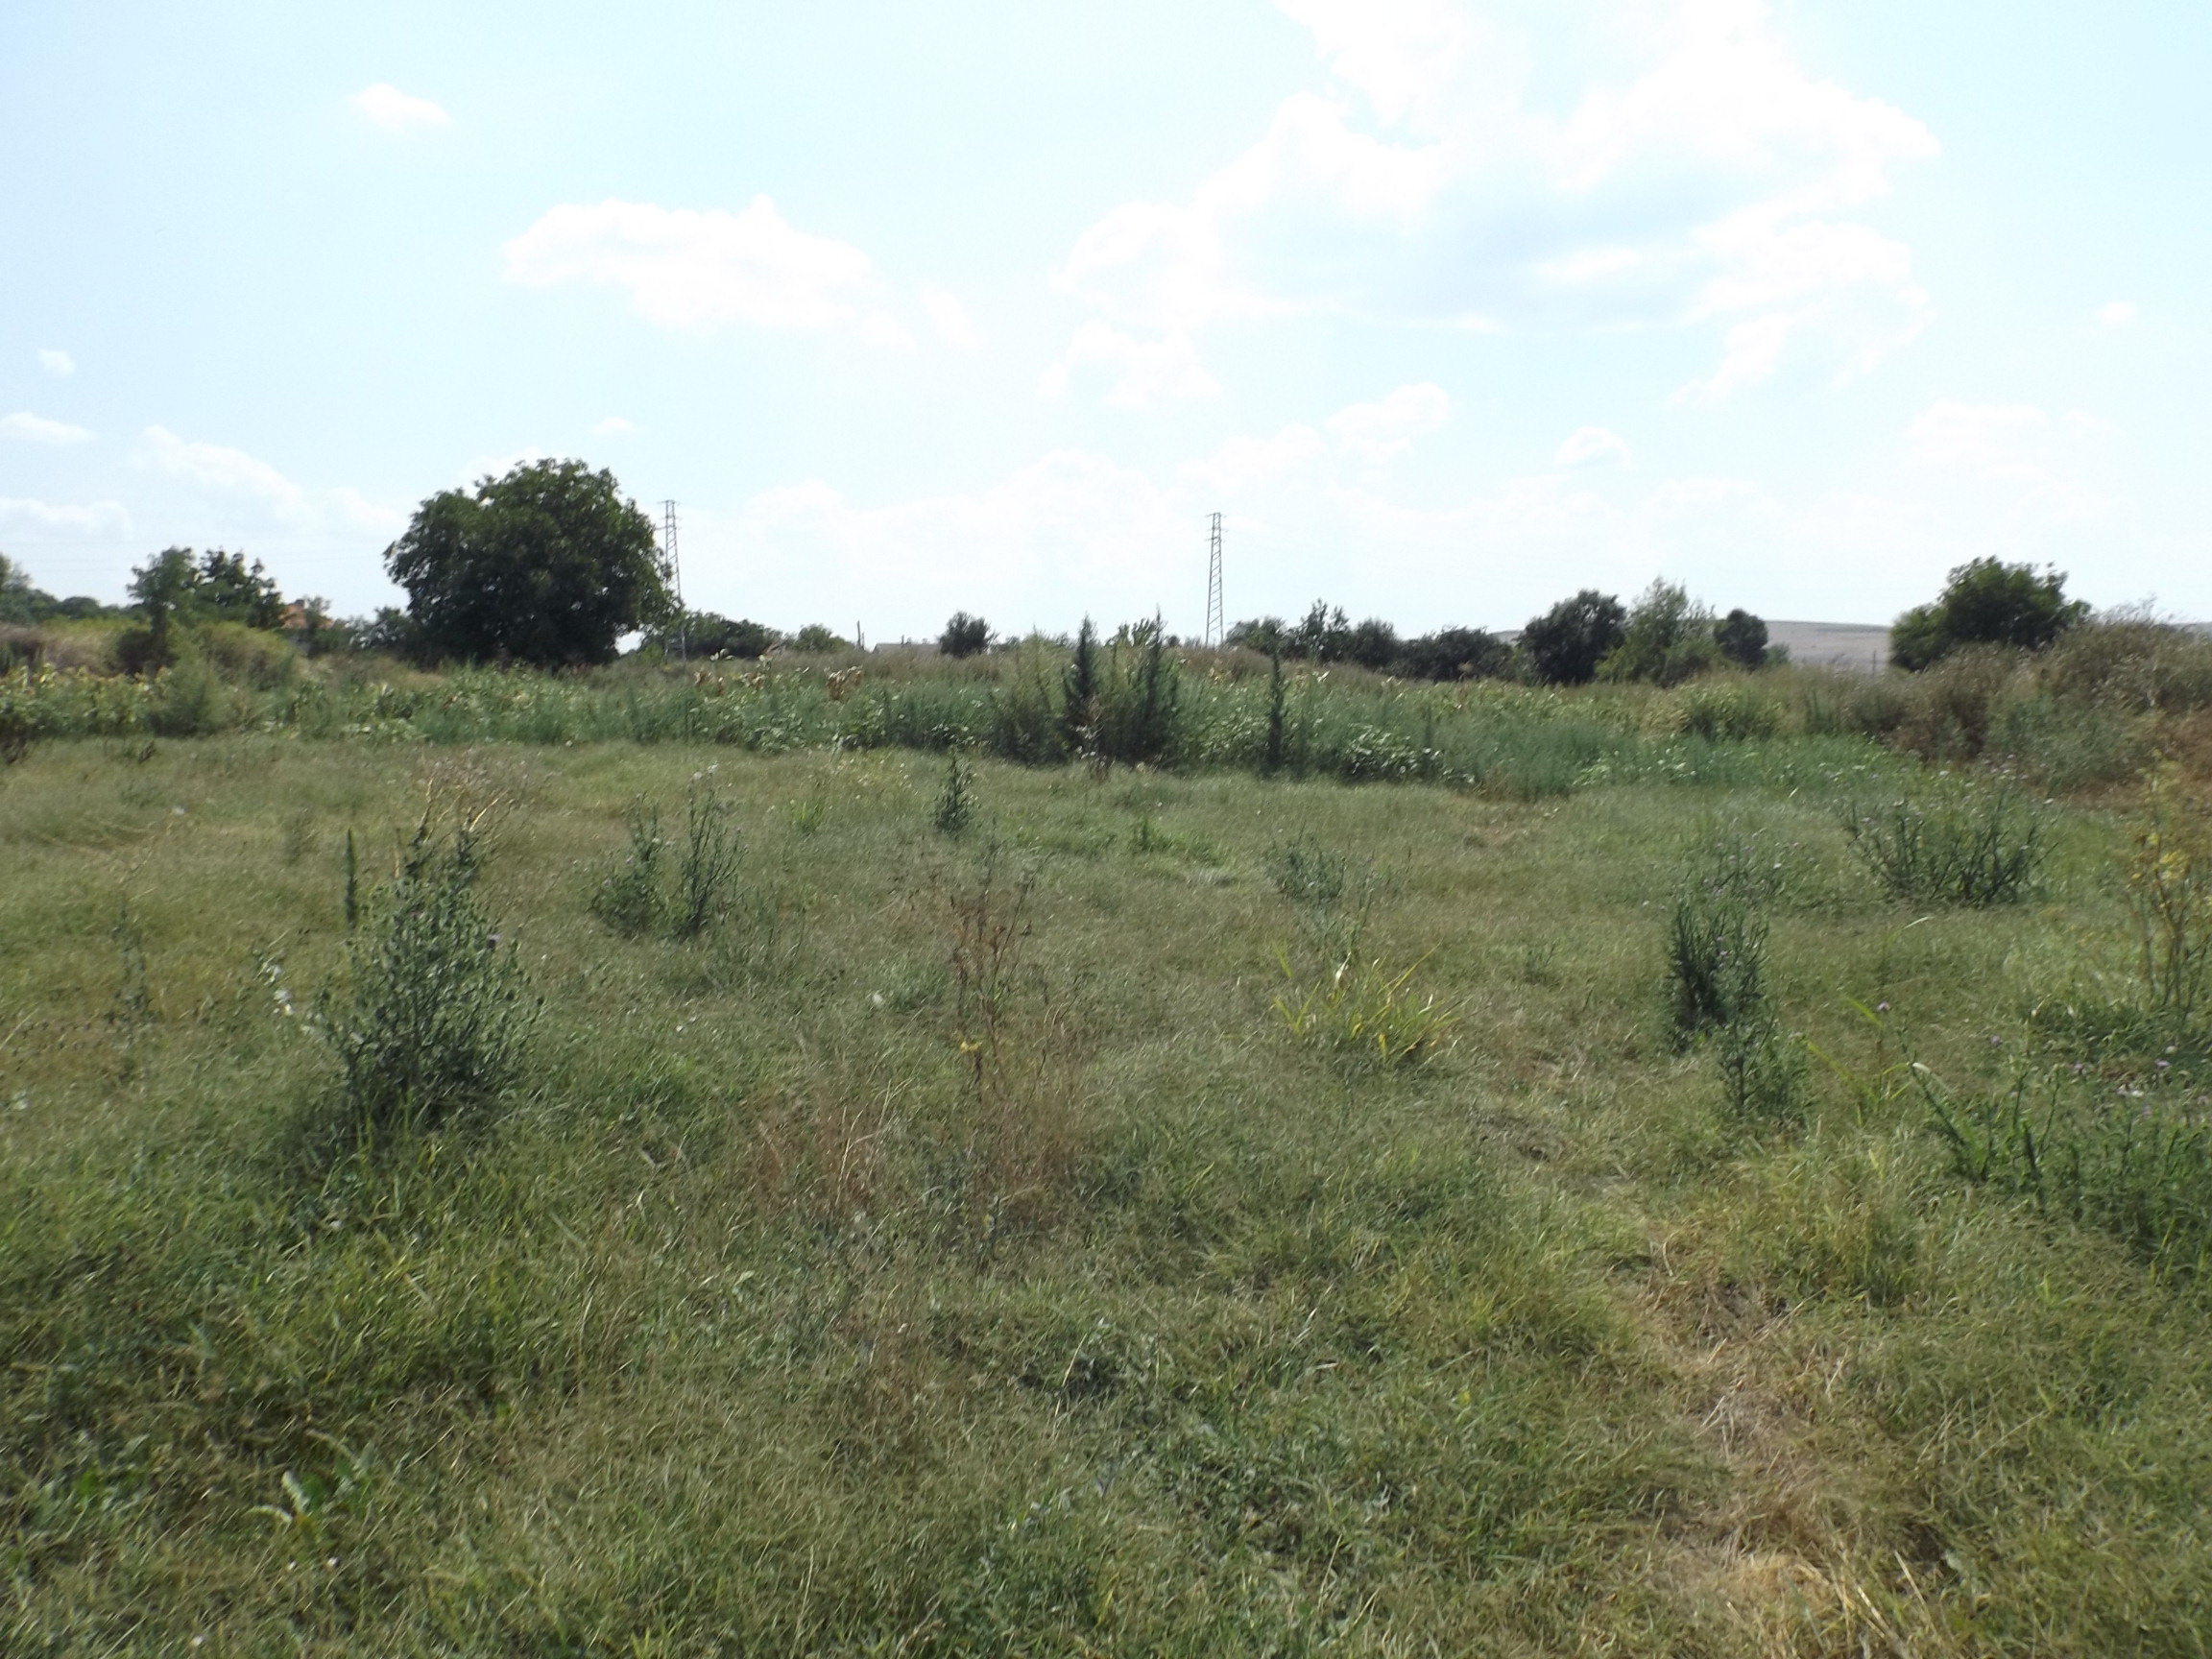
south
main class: Grassland
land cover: Spontaneously vegetated surfaces
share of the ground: > 75 %
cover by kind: herbaceous plants 95 %, shrubs 5 %
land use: Abandoned areas
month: August
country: BG
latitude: 43.2930
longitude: 27.5963
